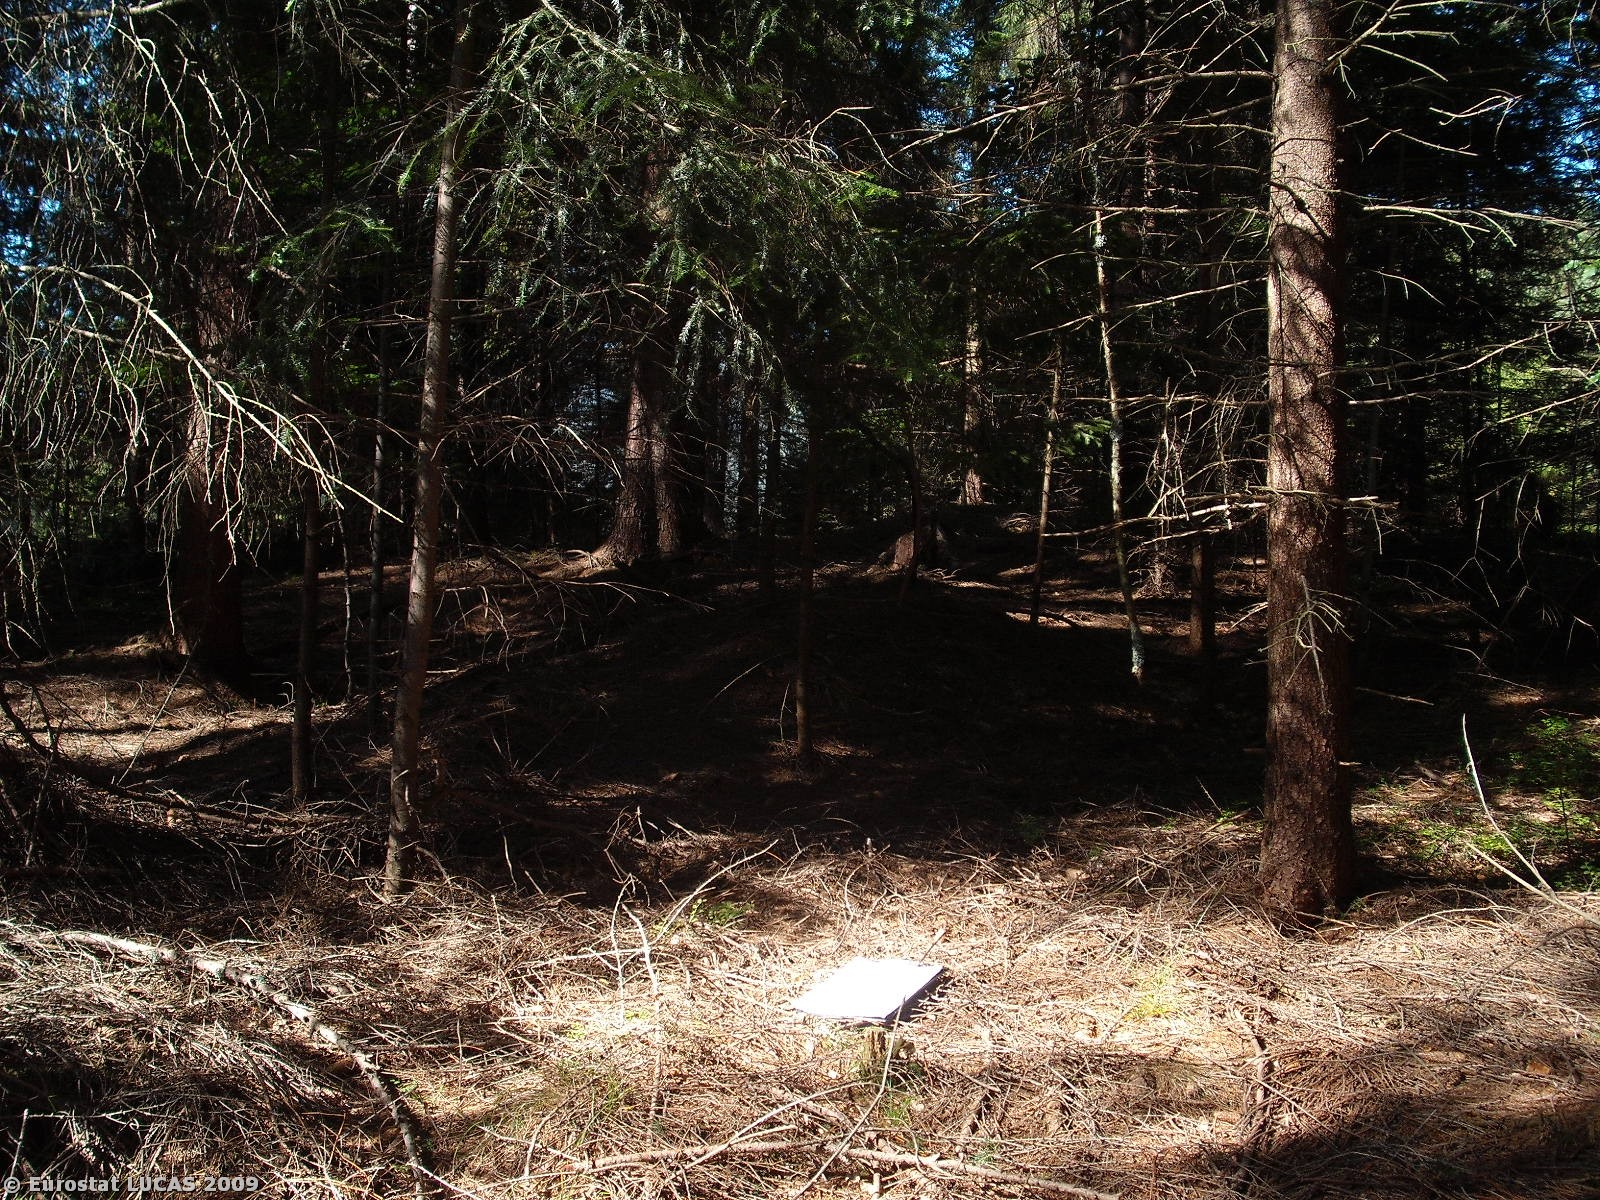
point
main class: Woodland
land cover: Coniferous woodland
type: hemiboreal forest and nemoral coniferous forest and mixed broadleaved-coniferous forest
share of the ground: > 75 %
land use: Forestry
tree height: > 5 m
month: September
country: PL
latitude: 49.5602
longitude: 19.6085
